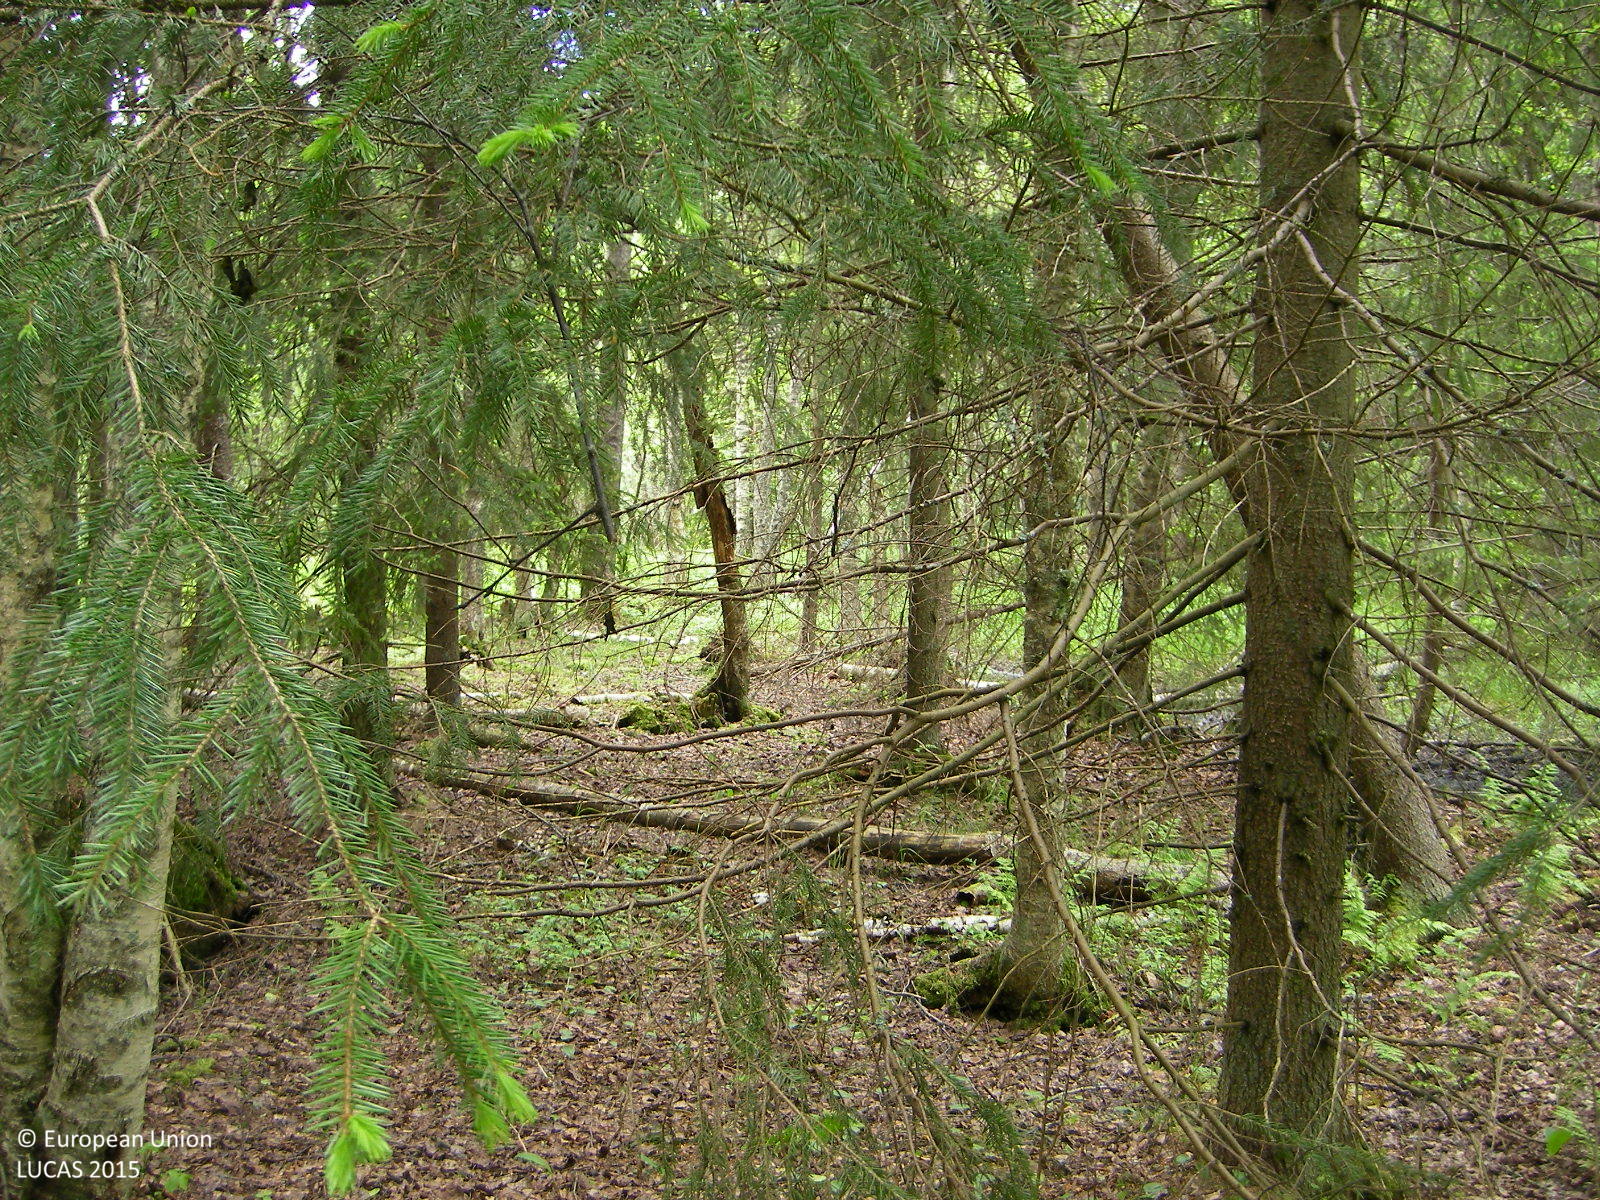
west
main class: Woodland
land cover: Spruce dominated mixed woodland
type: boreal forest
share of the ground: > 75 %
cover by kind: broadleaved forest trees 50 %, coniferous forest trees 40 %, herbaceous plants 10 %
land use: Semi-natural and natural areas not in use
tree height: > 5 m
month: June
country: FI
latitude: 60.1935
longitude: 24.7037
